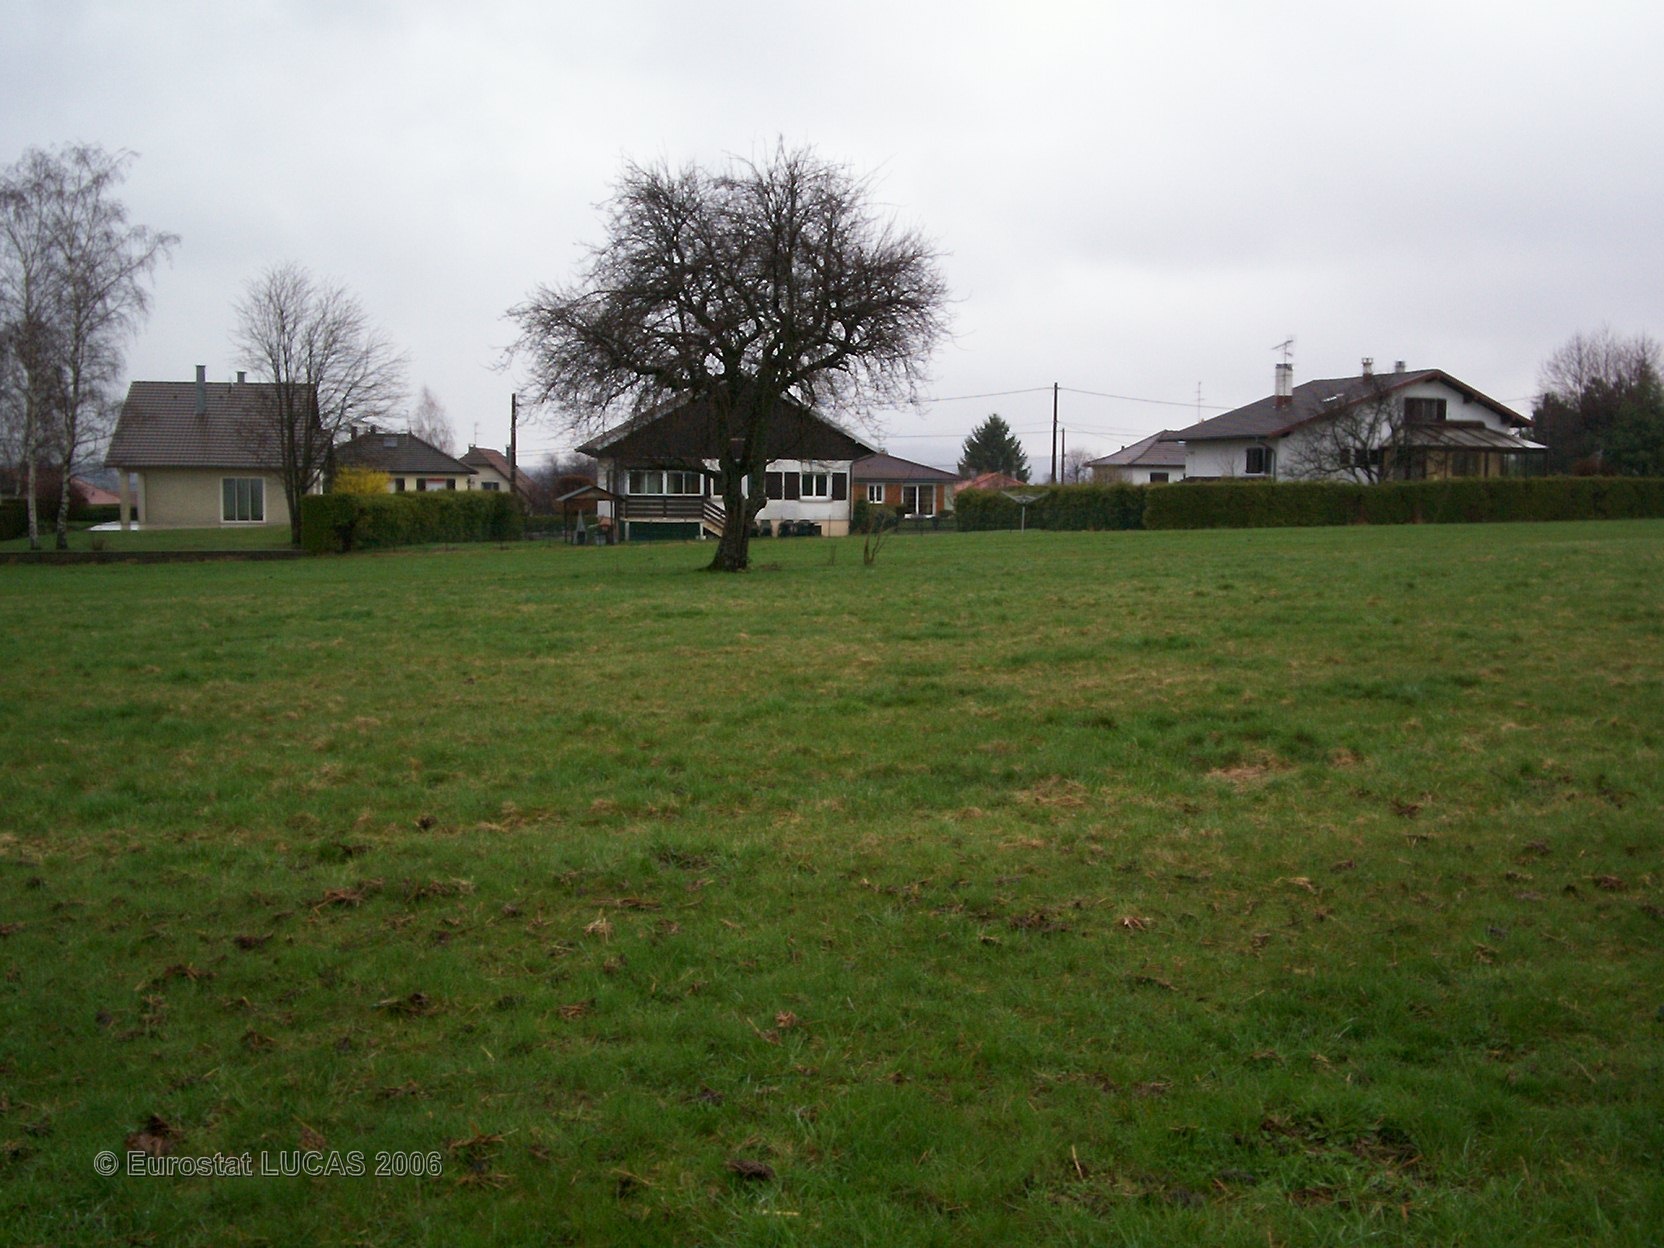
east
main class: Grassland
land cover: Grassland without tree/shrub cover
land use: Agriculture (excluding fallow land and kitchen gardens)
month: April
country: FR
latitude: 47.6734
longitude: 6.8183
